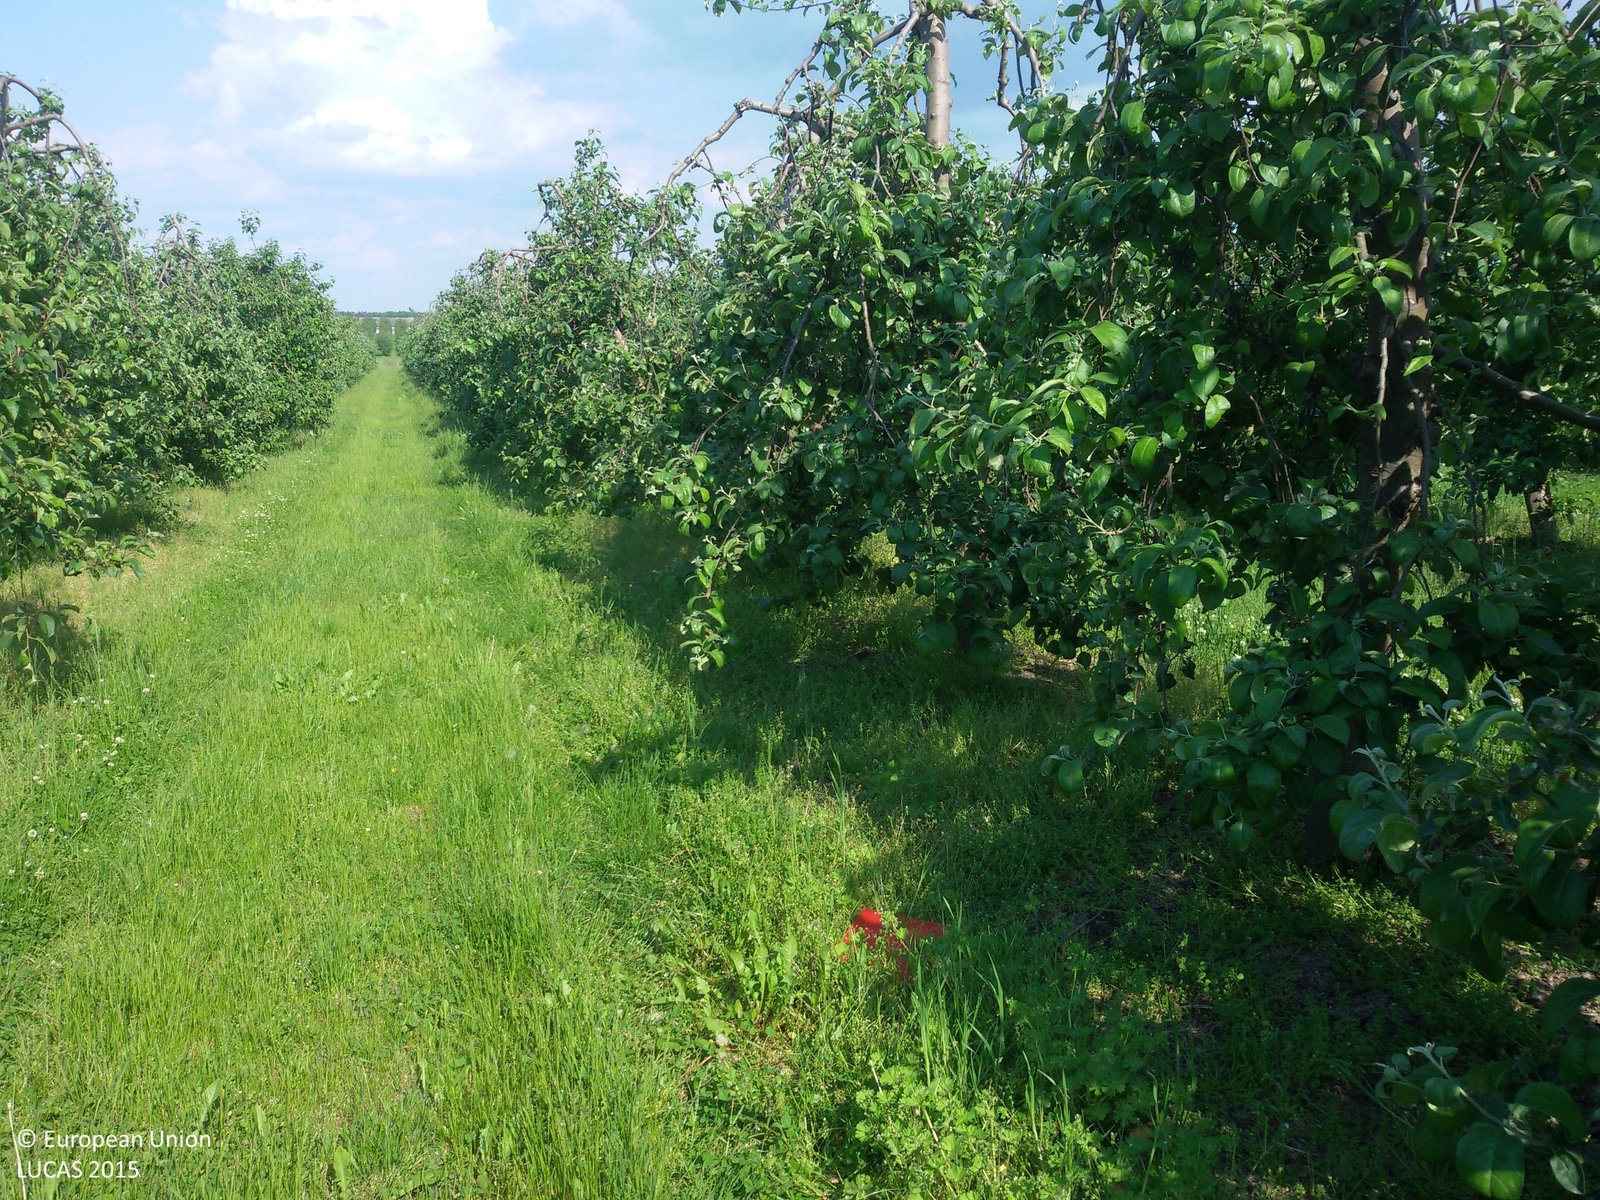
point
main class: Cropland
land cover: Apple fruit
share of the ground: 25 - 50 %
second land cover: Grassland without tree/shrub cover
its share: > 75 %
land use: Agriculture (excluding fallow land and kitchen gardens)
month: June
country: PL
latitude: 51.6446
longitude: 20.6328
